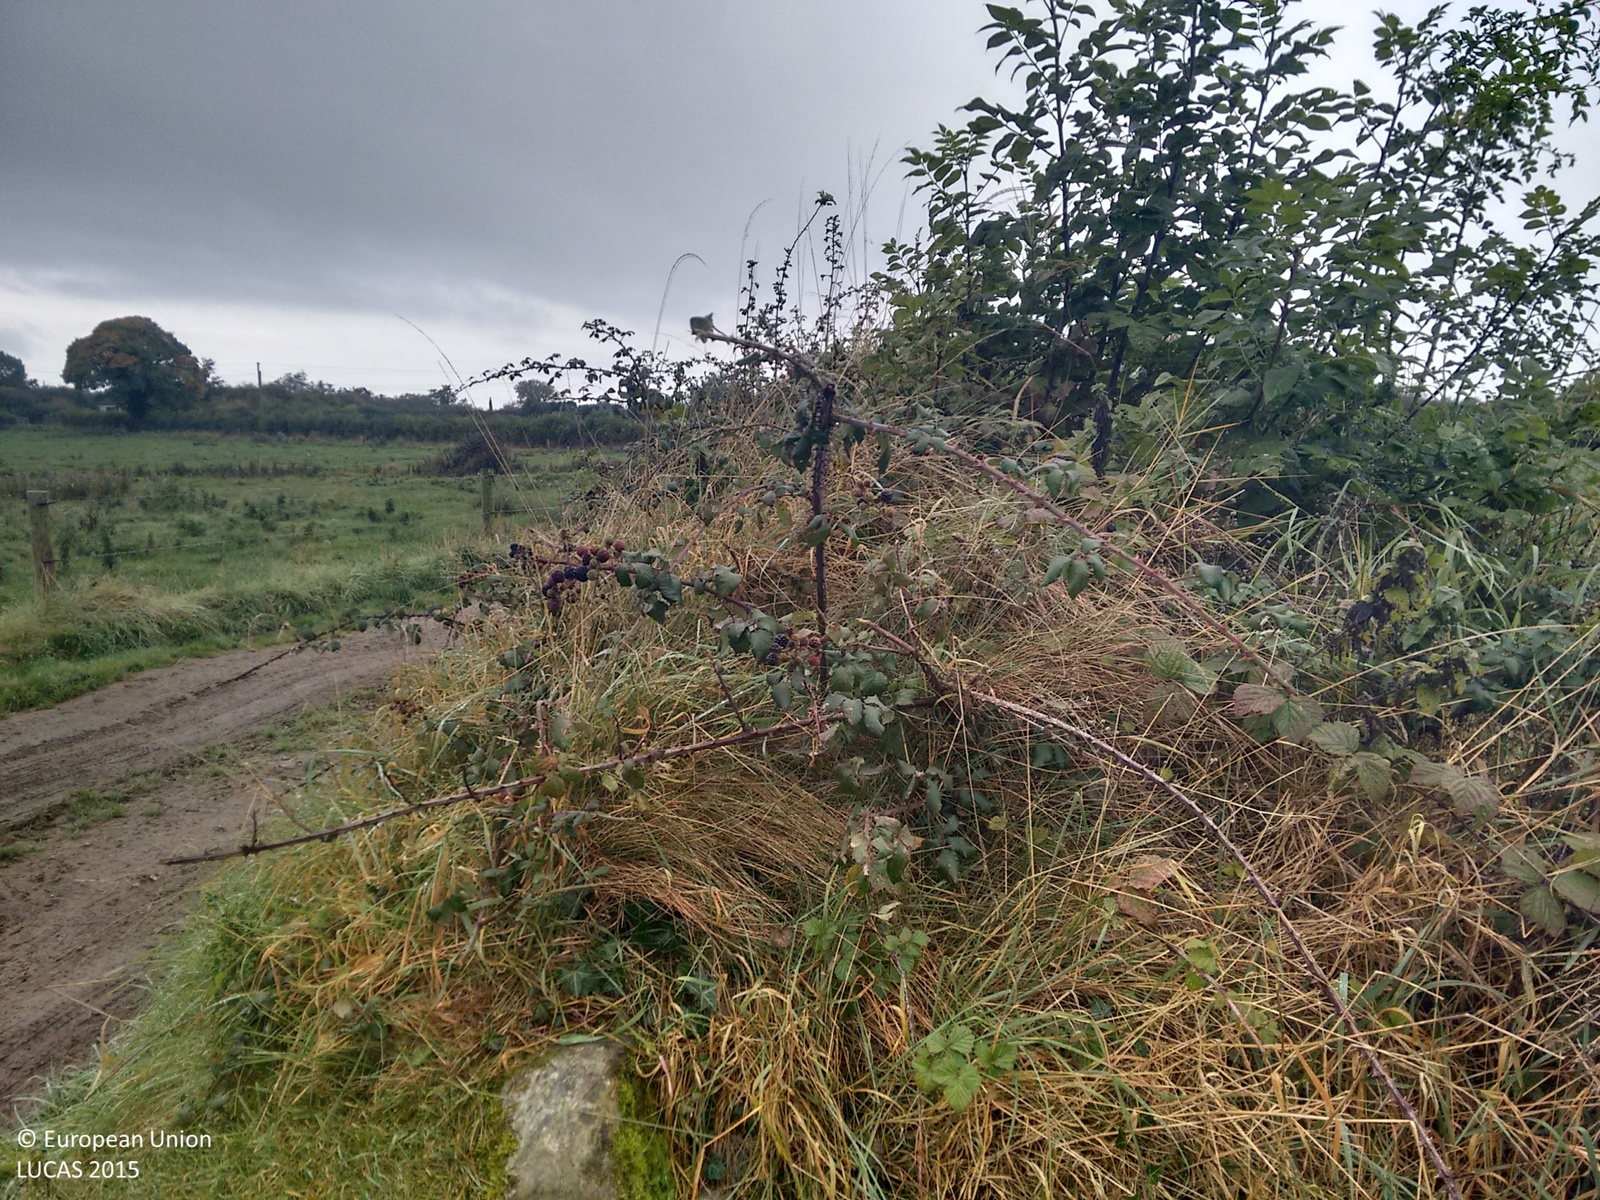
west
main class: Grassland
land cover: Grassland without tree/shrub cover
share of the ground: > 75 %
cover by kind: herbaceous plants 100 %
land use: Agriculture (excluding fallow land and kitchen gardens)
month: October
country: IE
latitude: 52.6477
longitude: -7.7409
